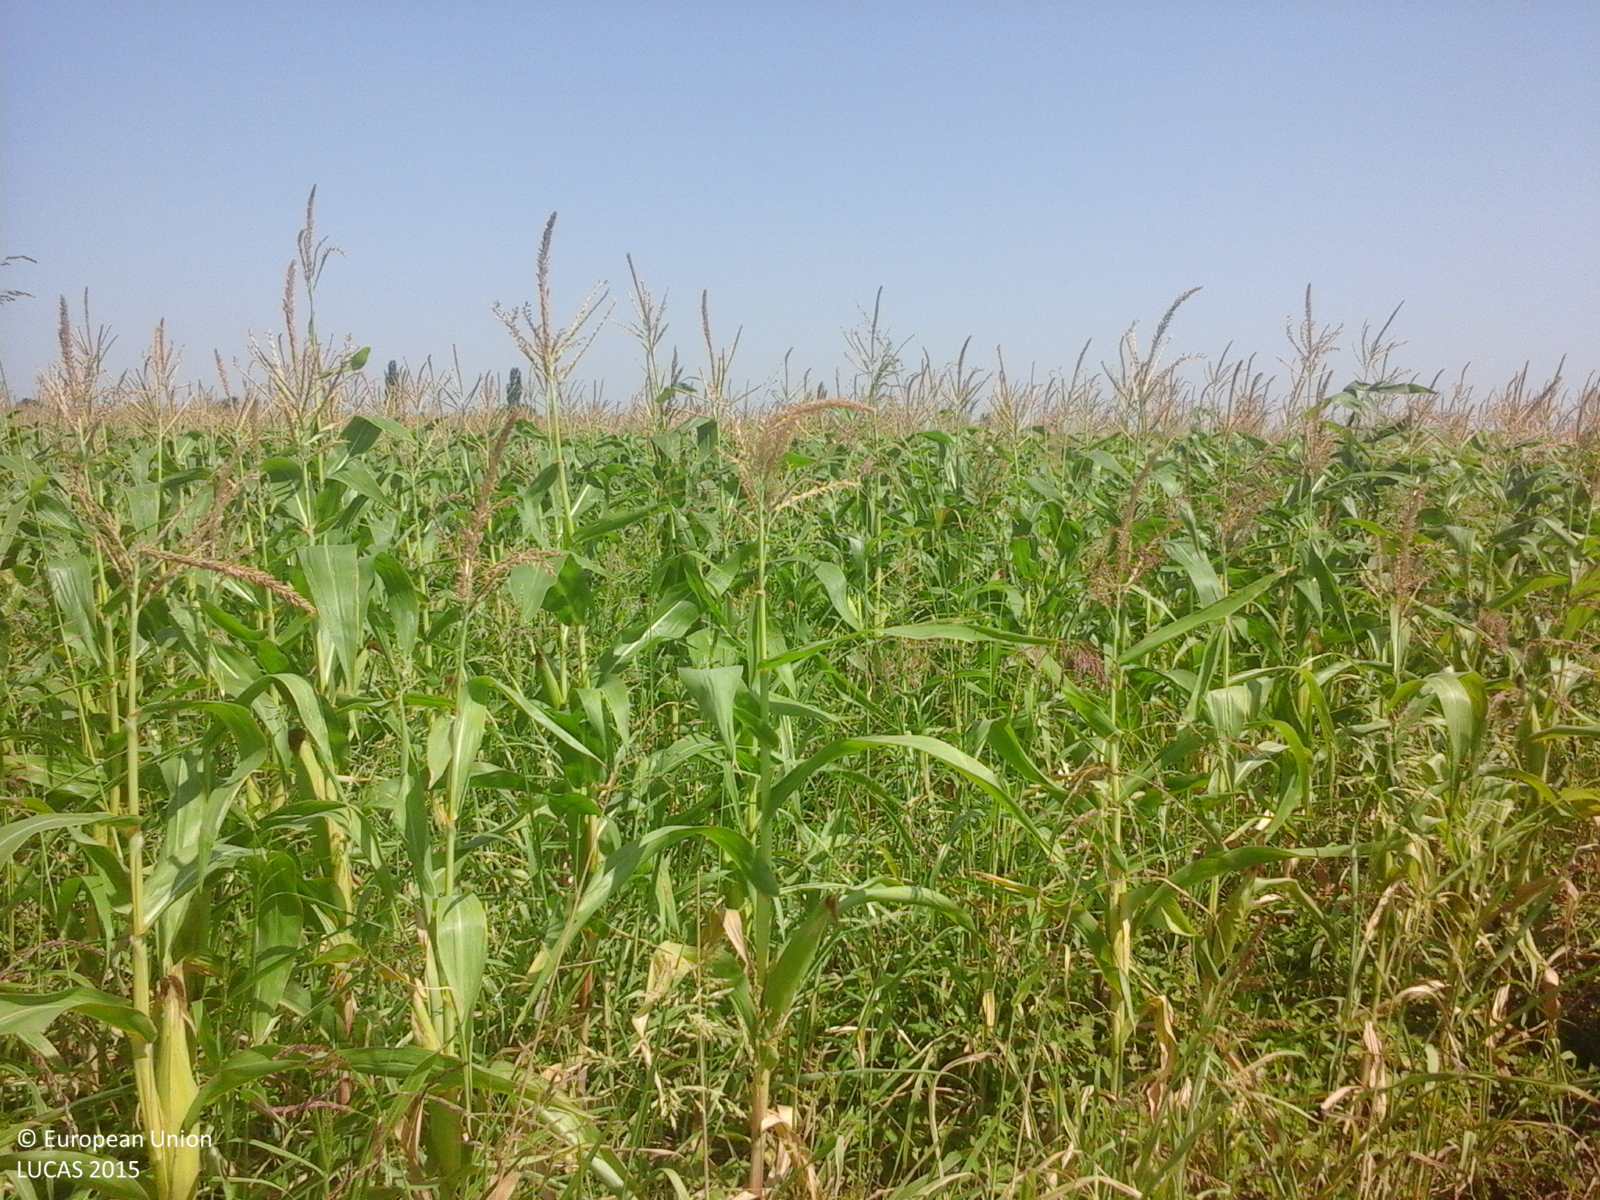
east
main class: Cropland
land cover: Maize
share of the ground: > 75 %
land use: Agriculture (excluding fallow land and kitchen gardens)
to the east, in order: Maize; Other bare soil; Barley; Maize; Tracks
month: August
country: RO
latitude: 45.1049
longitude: 26.8956
